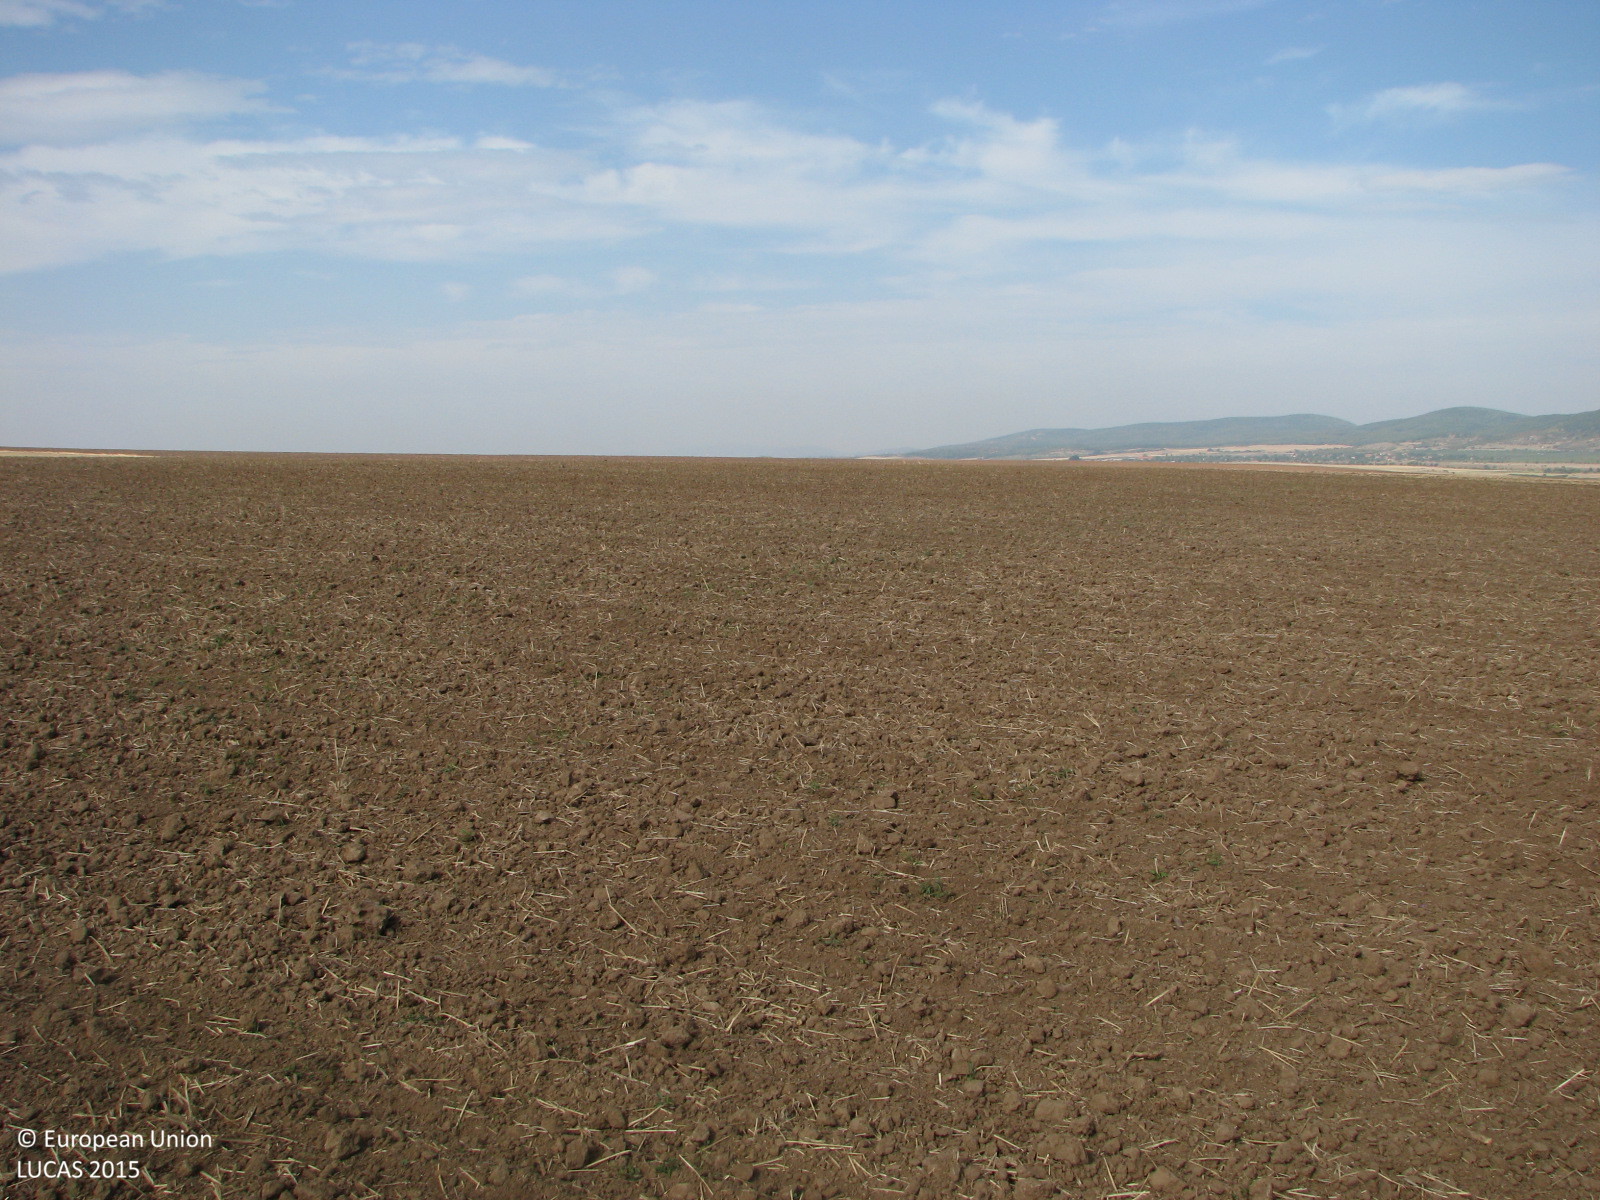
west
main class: Cropland
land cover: Common wheat
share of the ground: < 10 %
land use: Agriculture (excluding fallow land and kitchen gardens)
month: September
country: BG
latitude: 42.5707
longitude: 26.2034
